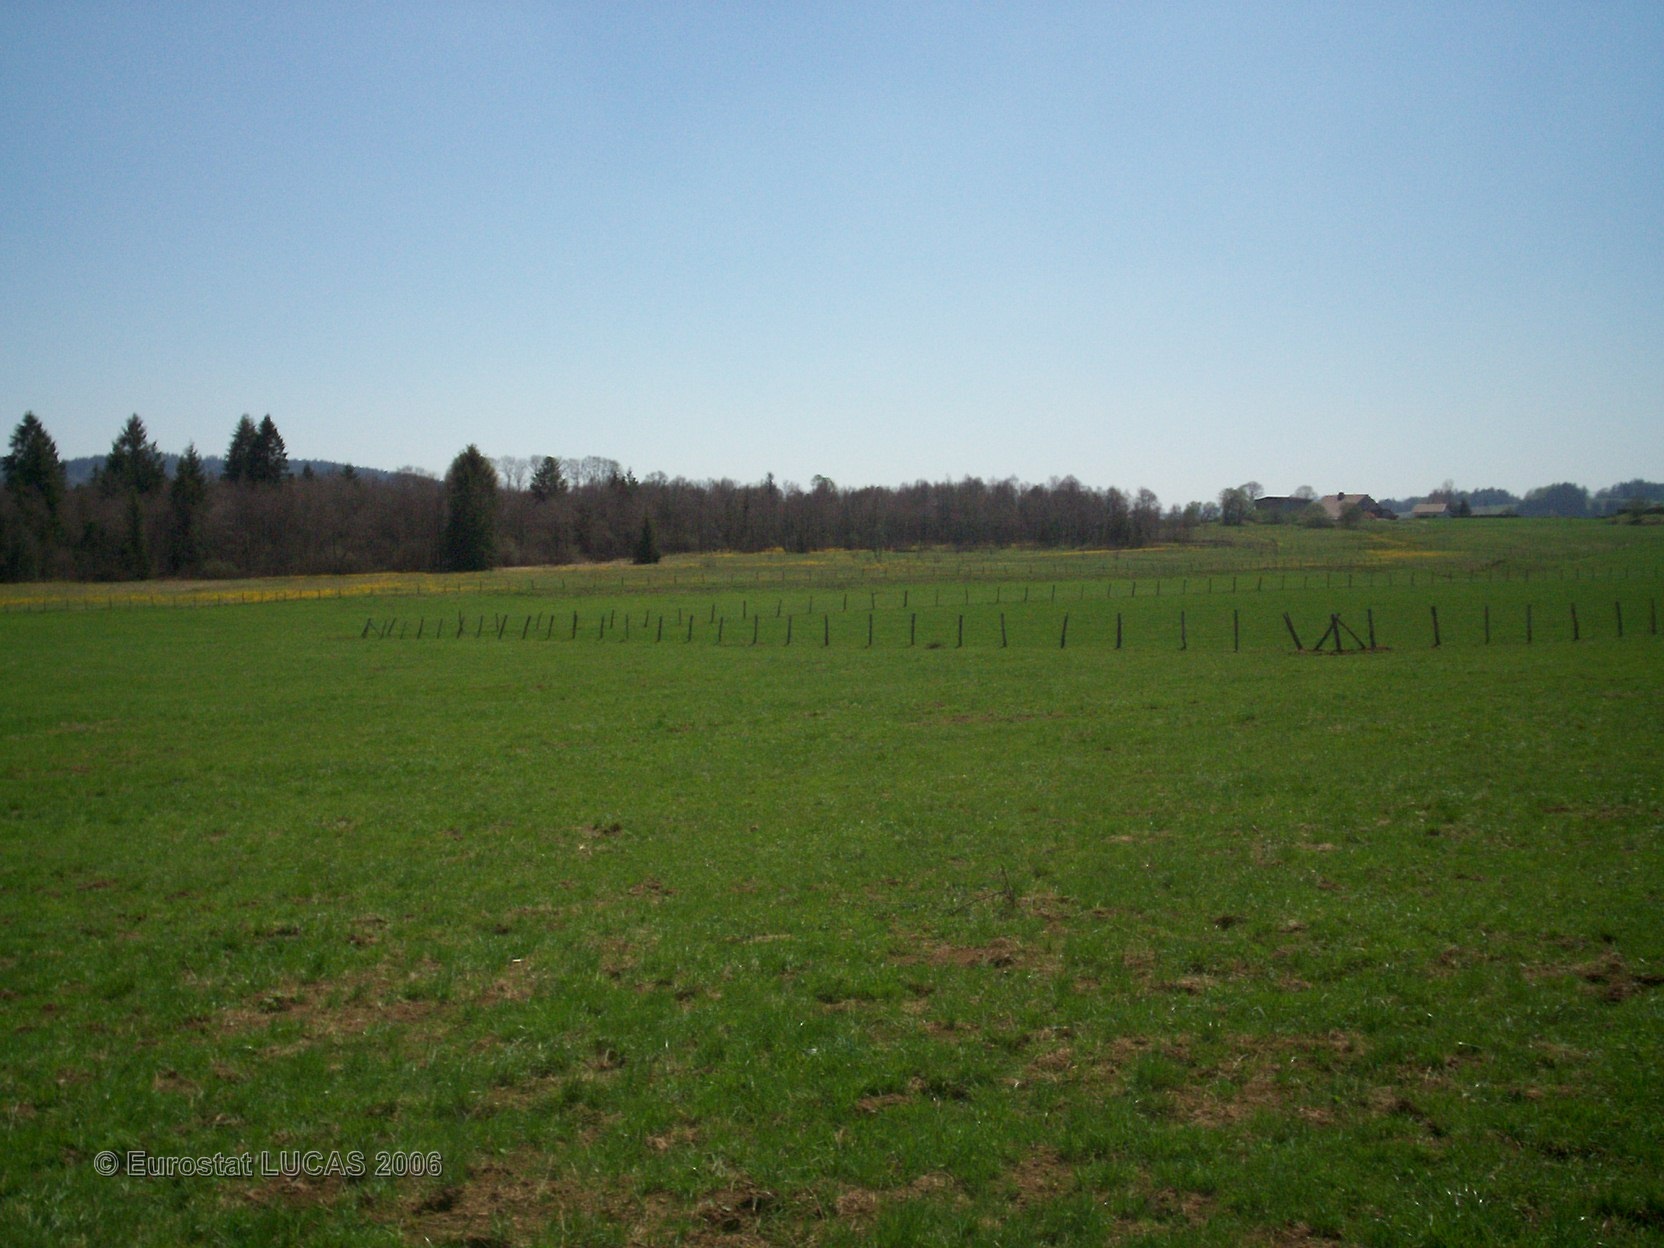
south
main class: Grassland
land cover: Grassland without tree/shrub cover
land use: Agriculture (excluding fallow land and kitchen gardens)
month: May
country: FR
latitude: 47.1096
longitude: 6.6418
